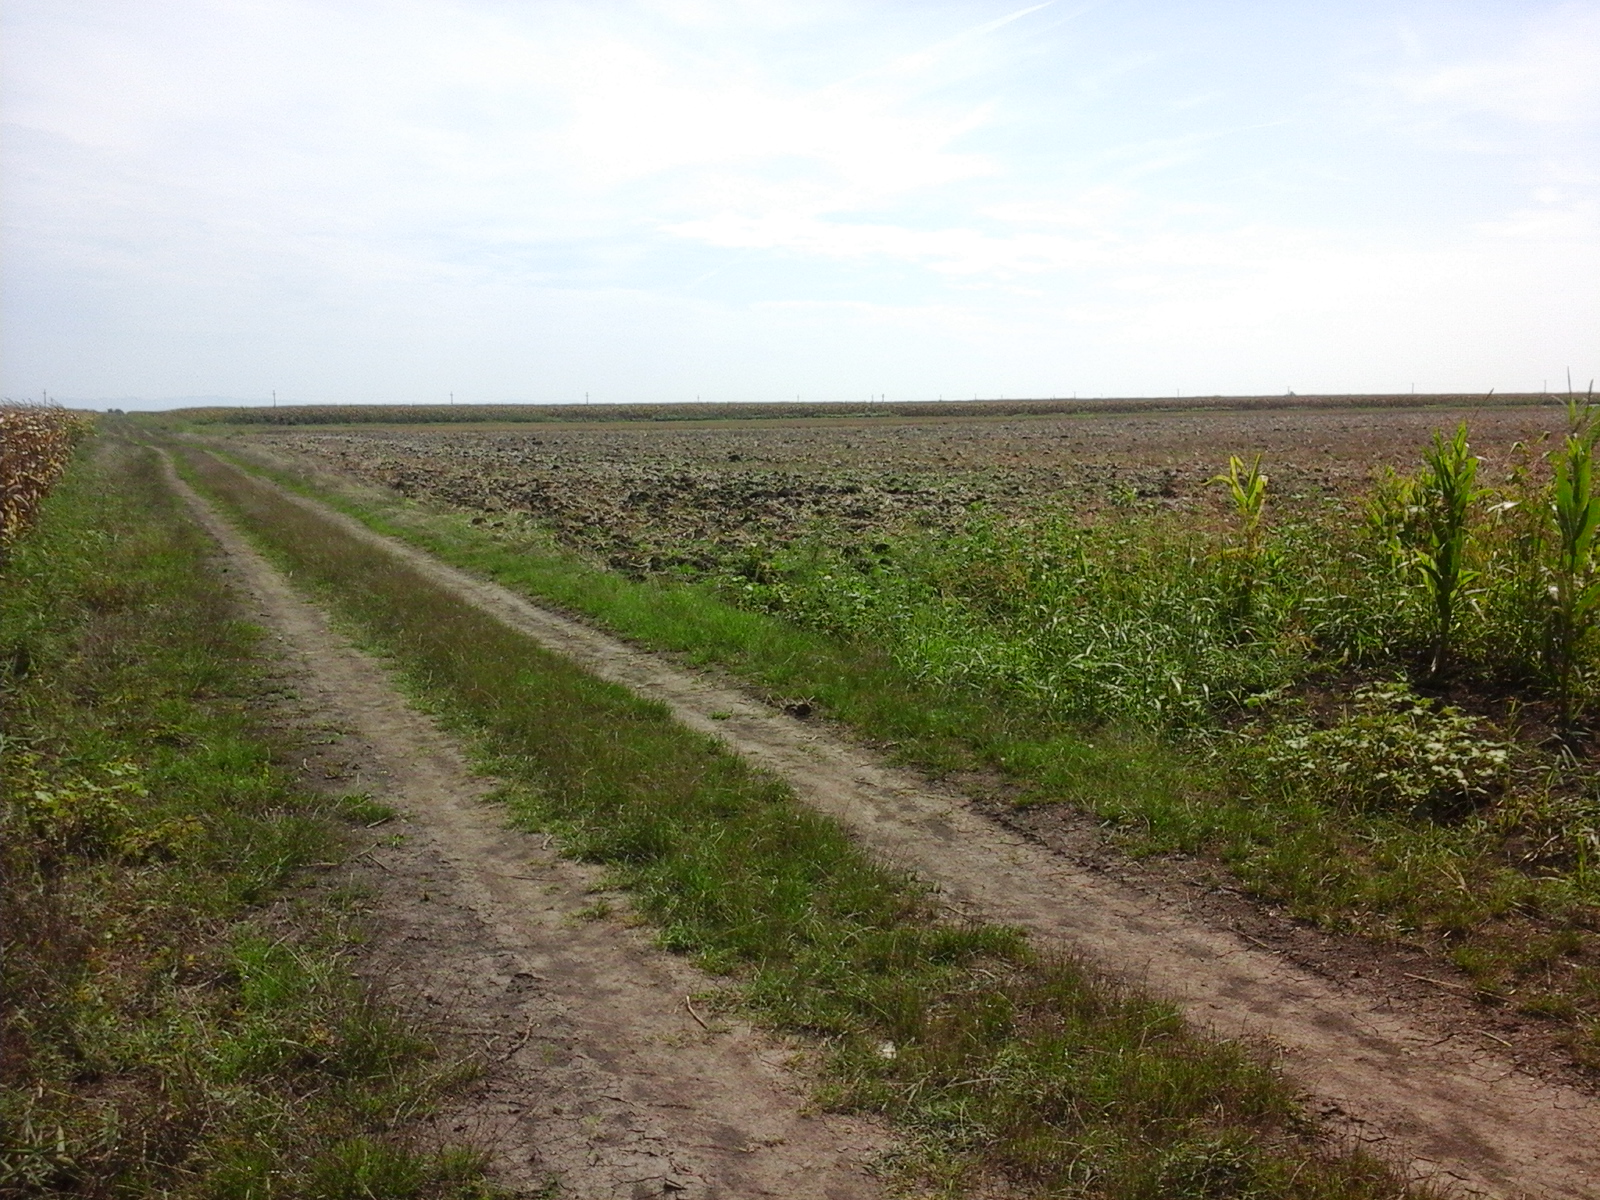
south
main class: Cropland
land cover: Maize
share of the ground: > 75 %
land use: Agriculture (excluding fallow land and kitchen gardens)
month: August
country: RO
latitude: 46.4718
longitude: 21.3533
